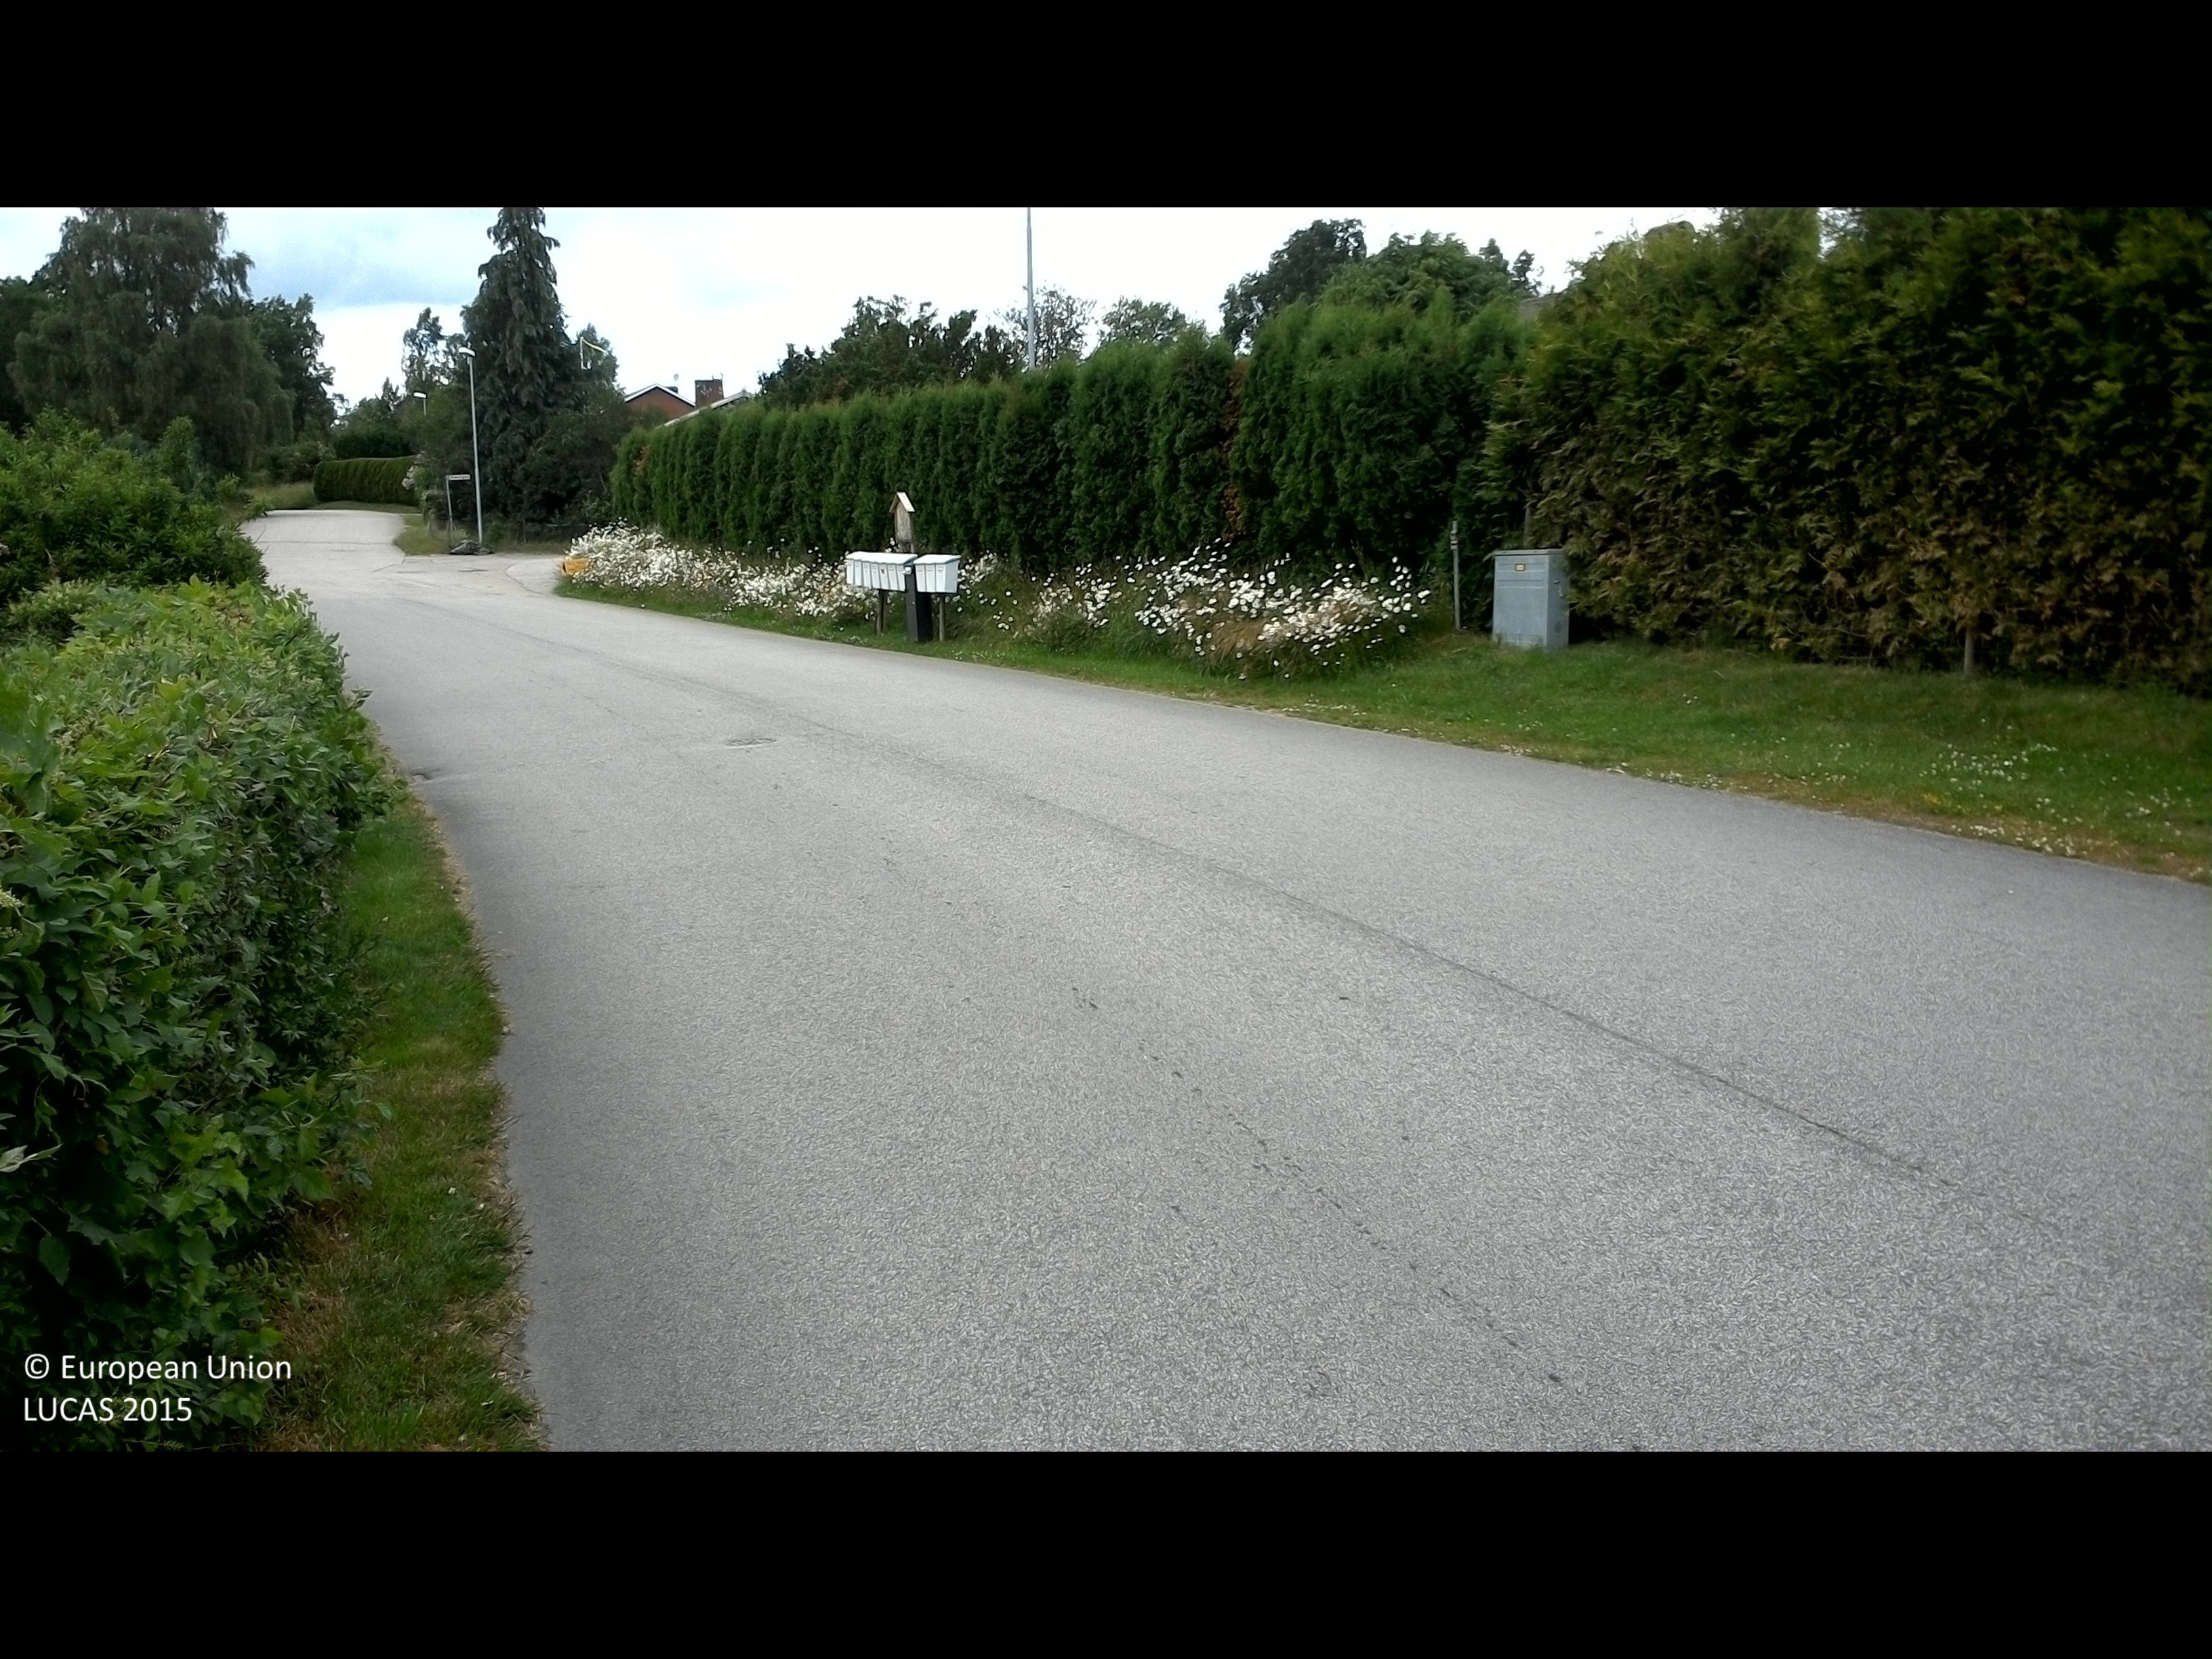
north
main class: Grassland
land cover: Grassland with sparse tree/shrub cover
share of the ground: > 75 %
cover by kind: herbaceous plants 85 %, shrubs 10 %, broadleaved forest trees 5 %
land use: Residential
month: July
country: SE
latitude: 56.3927
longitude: 15.1013
